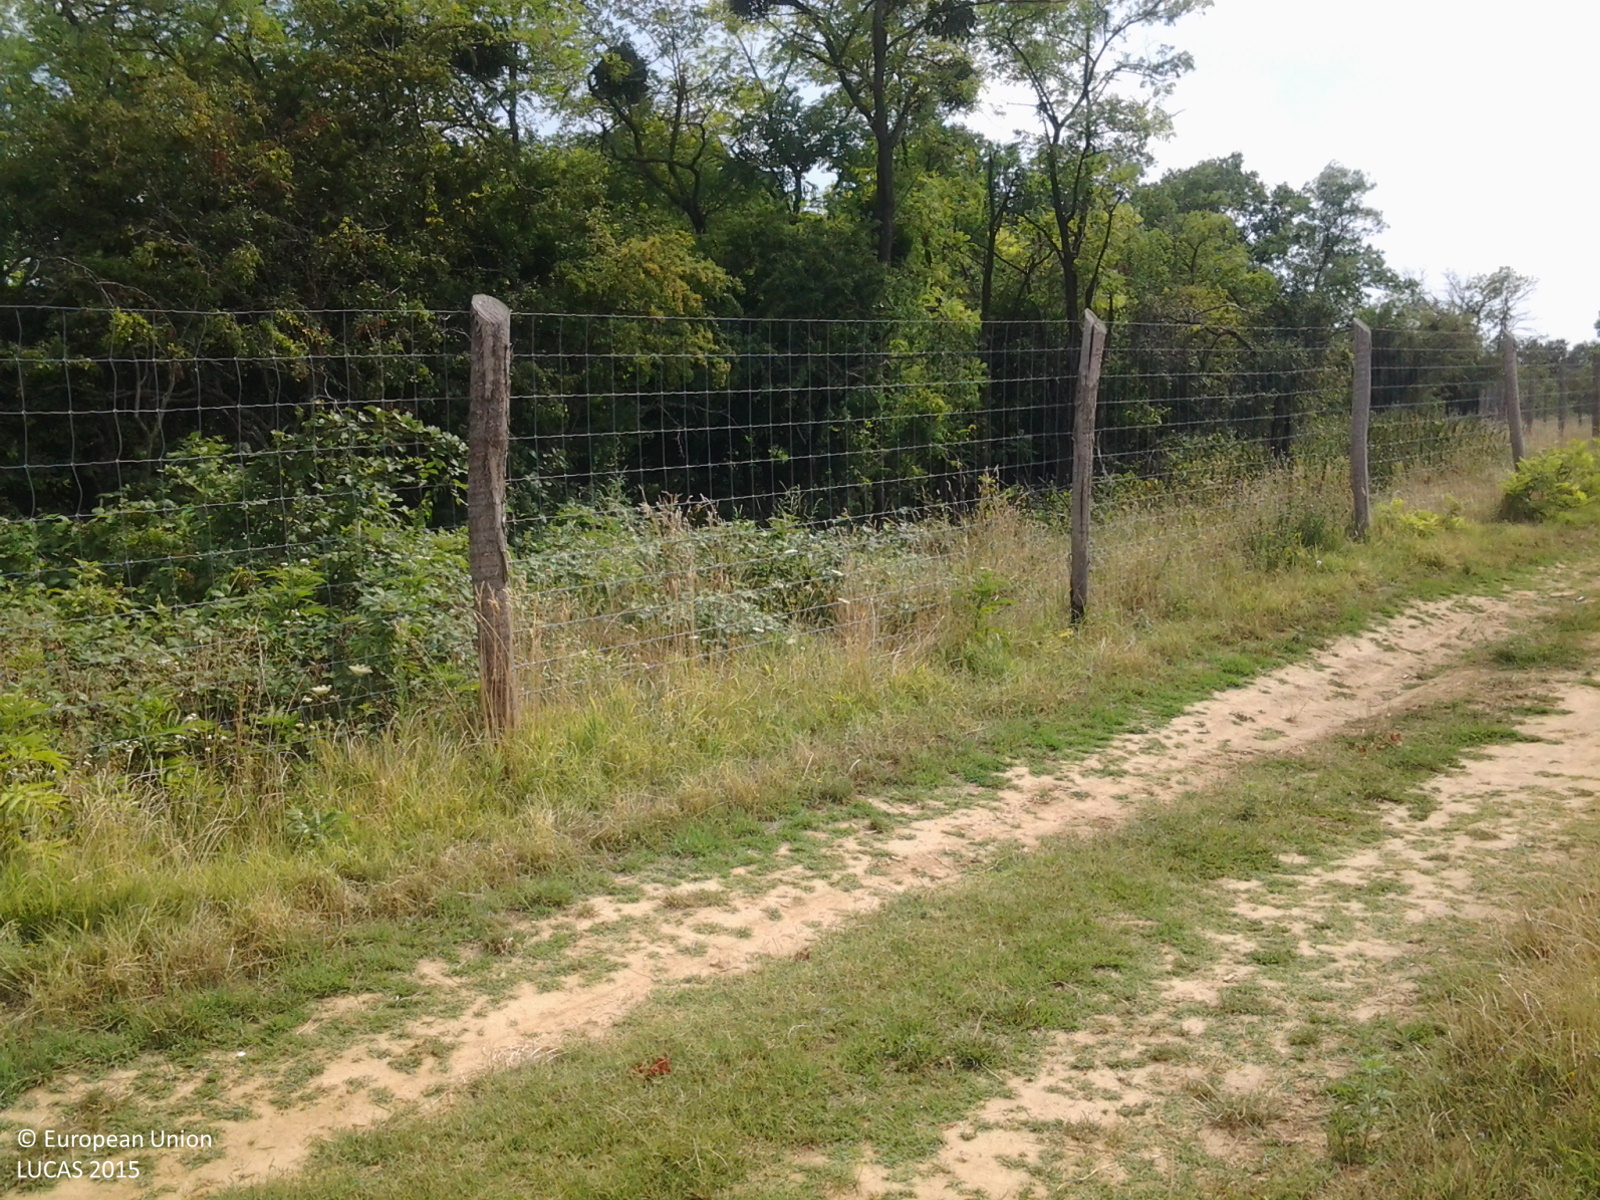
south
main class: Cropland
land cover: Vineyards
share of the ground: 50 - 75 %
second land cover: Spontaneously vegetated surfaces
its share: 25 - 50 %
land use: Agriculture (excluding fallow land and kitchen gardens)
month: July
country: HU
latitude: 46.4206
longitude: 18.3755
